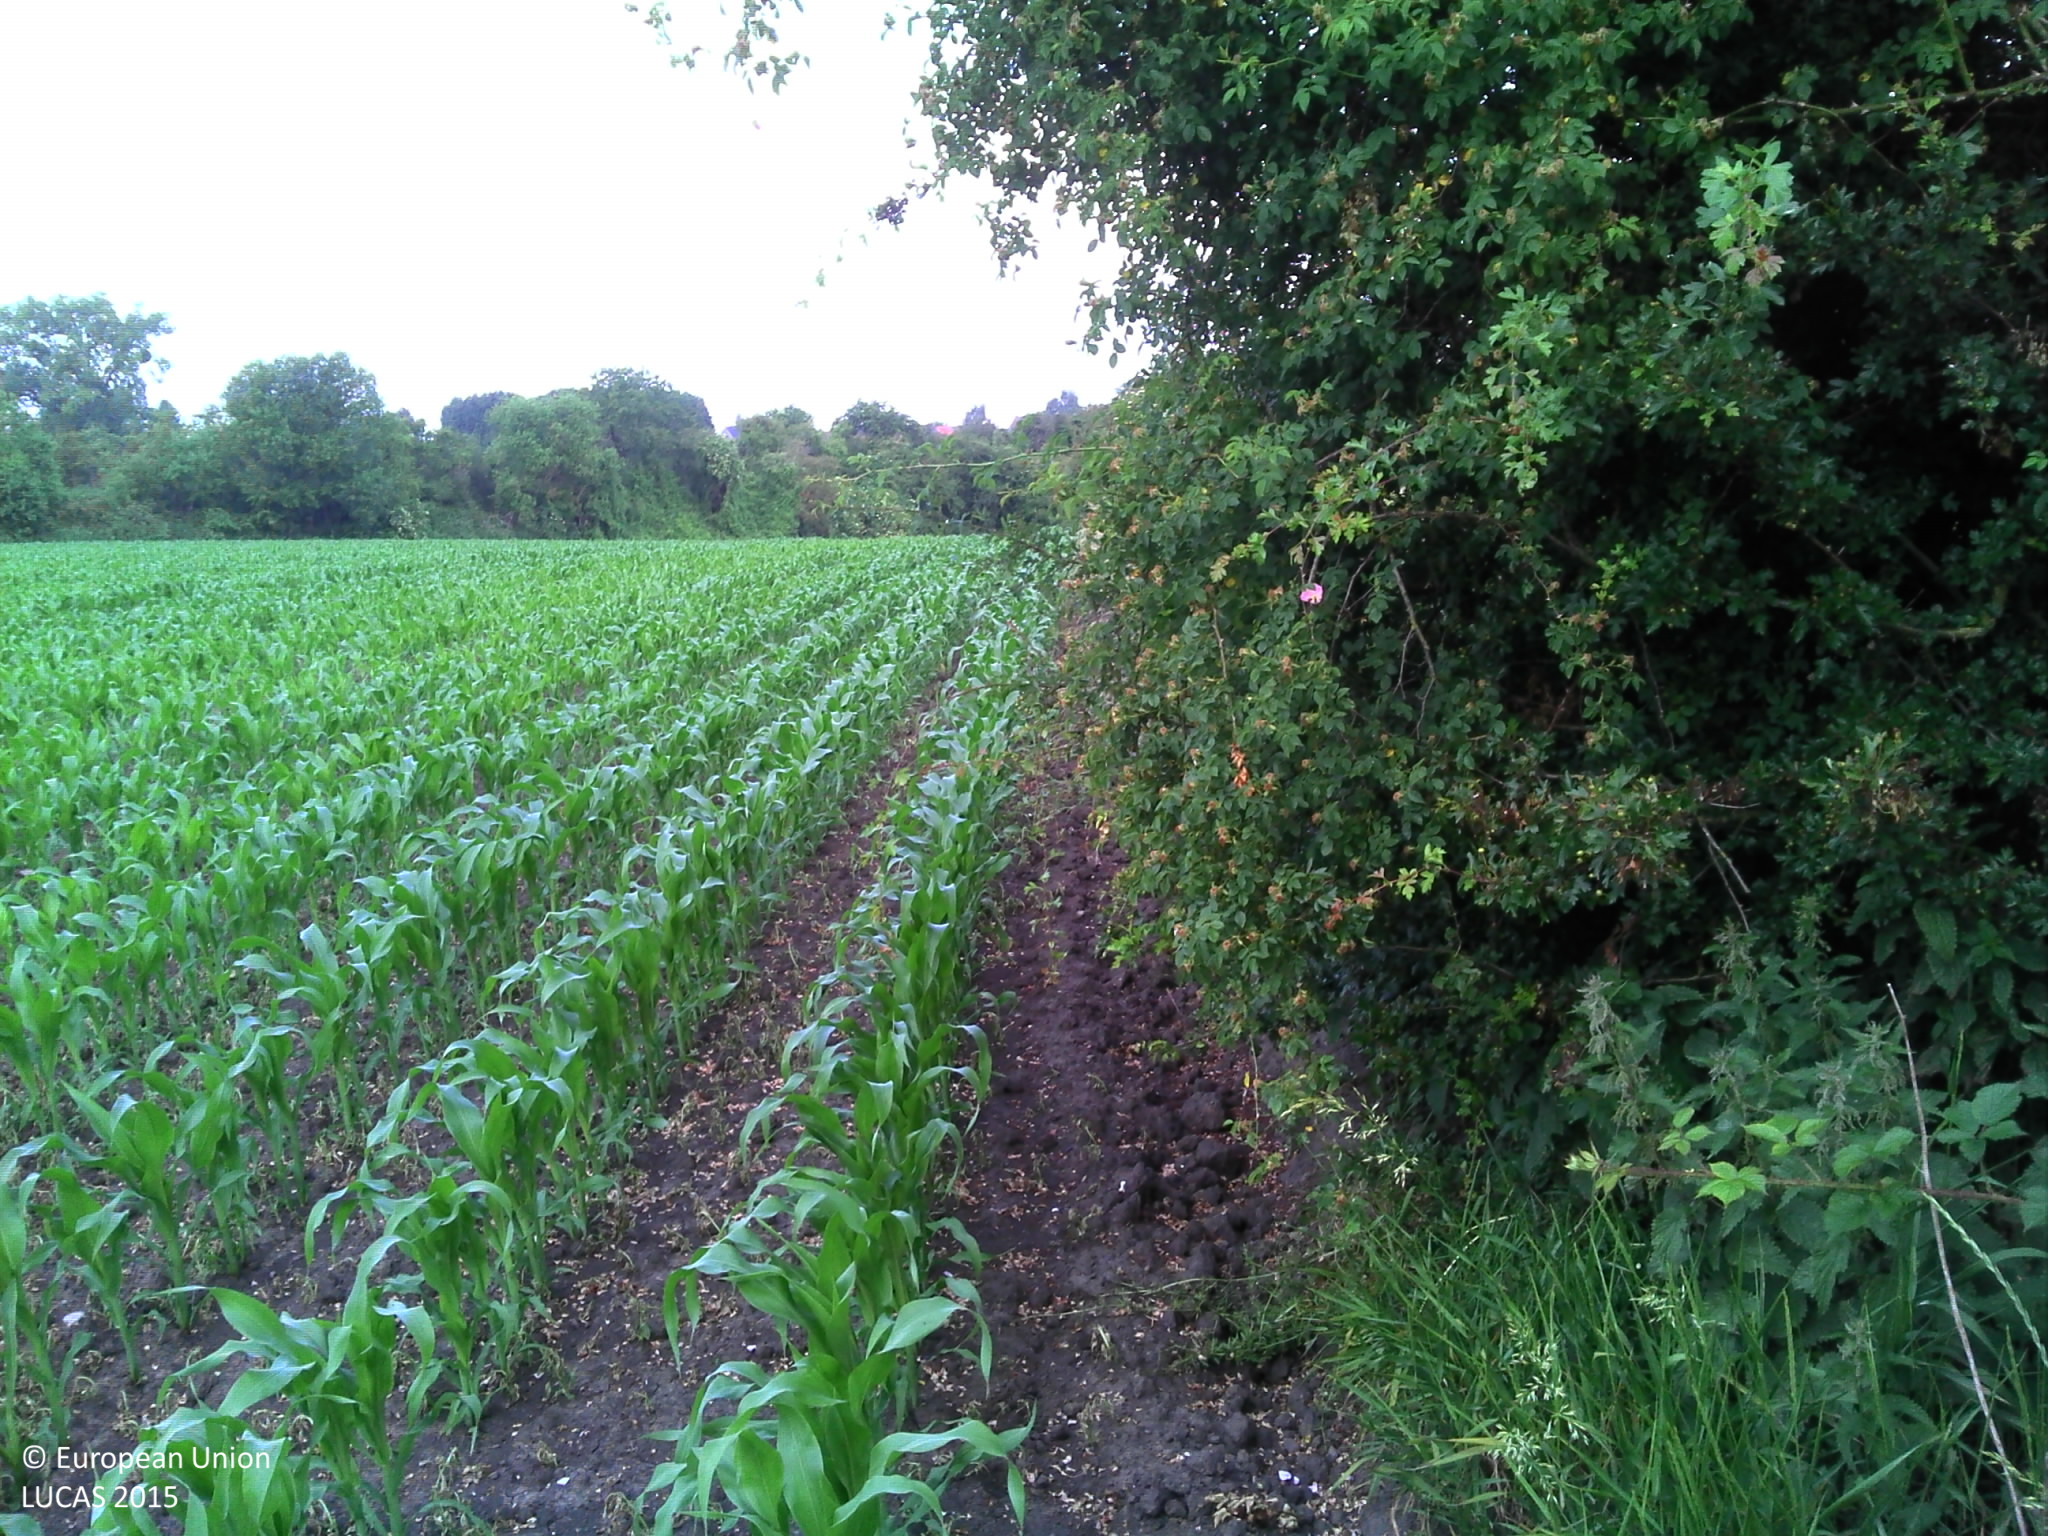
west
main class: Cropland
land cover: Maize
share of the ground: 25 - 50 %
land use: Agriculture (excluding fallow land and kitchen gardens)
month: June
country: BE
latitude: 50.4177
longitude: 3.8999
